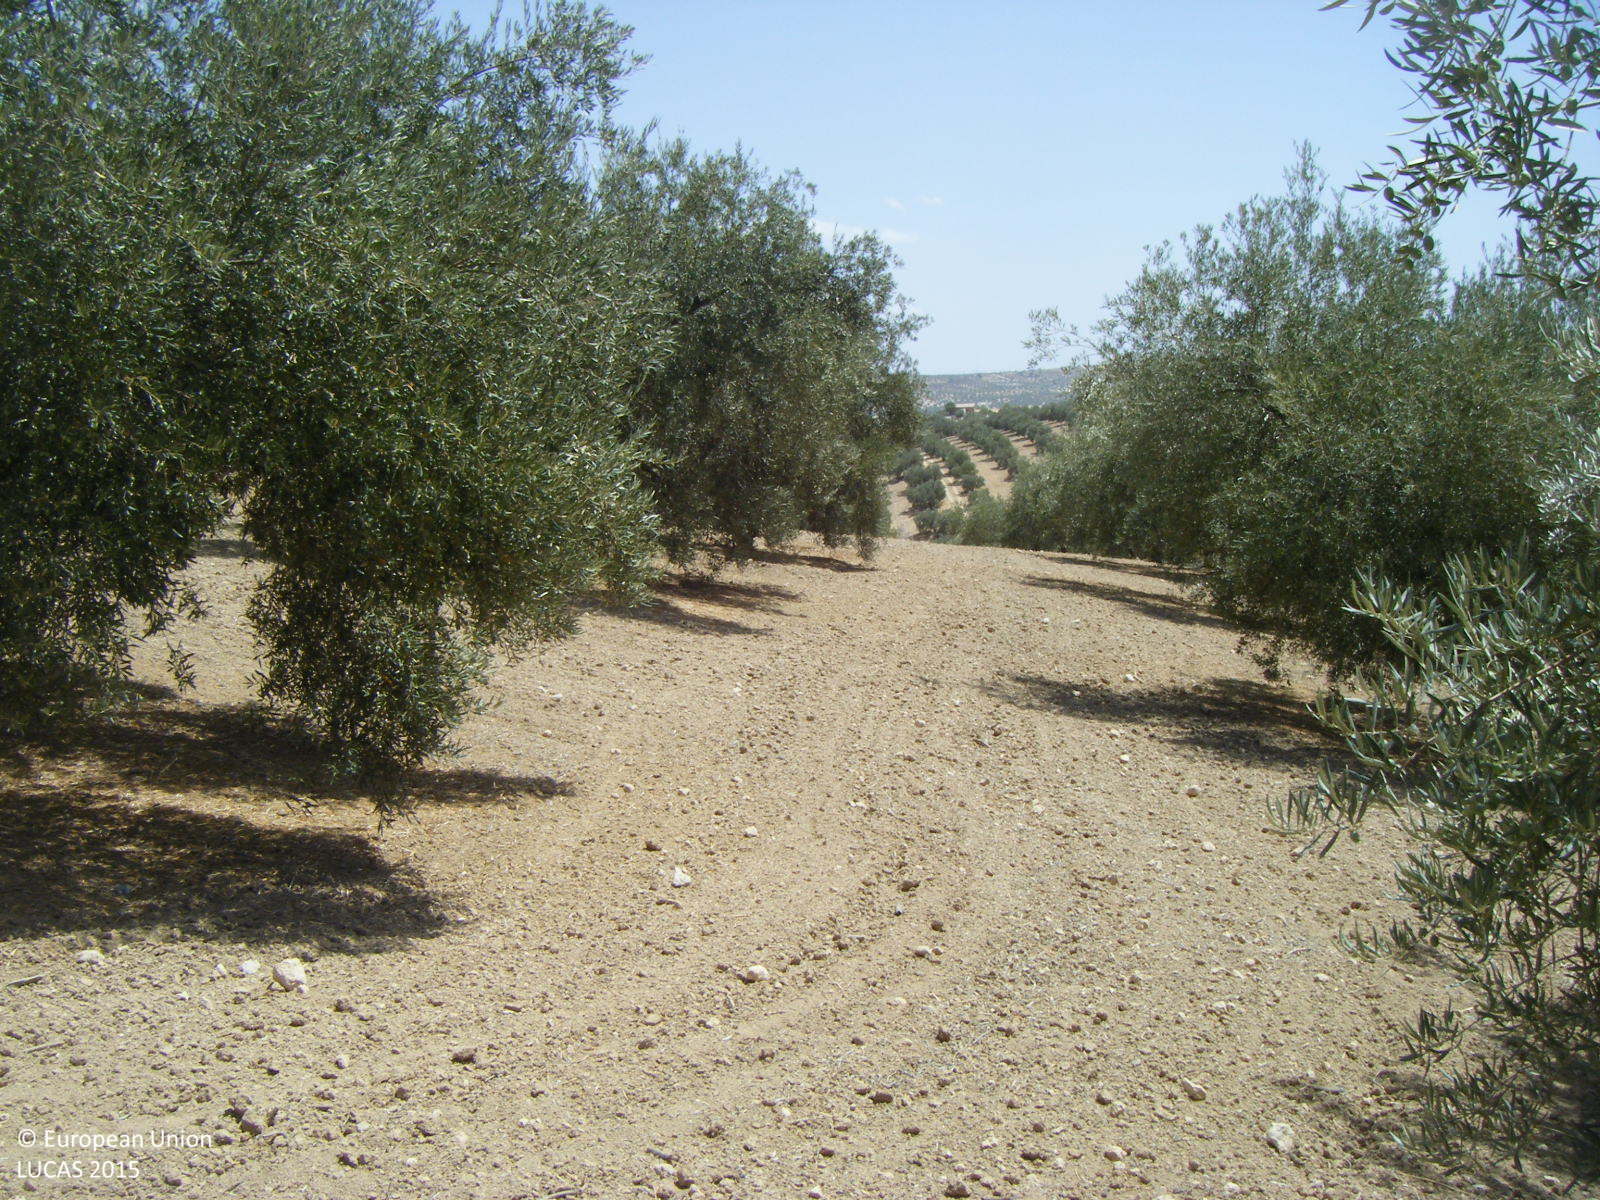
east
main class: Cropland
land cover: Olive groves
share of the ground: 25 - 50 %
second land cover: Other bare soil
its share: > 75 %
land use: Agriculture (excluding fallow land and kitchen gardens)
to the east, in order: Olive groves; Other bare soil; Broadleaved woodland; Paved roads, cycling and walking lanes
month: August
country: ES
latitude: 37.1360
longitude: -4.0759
